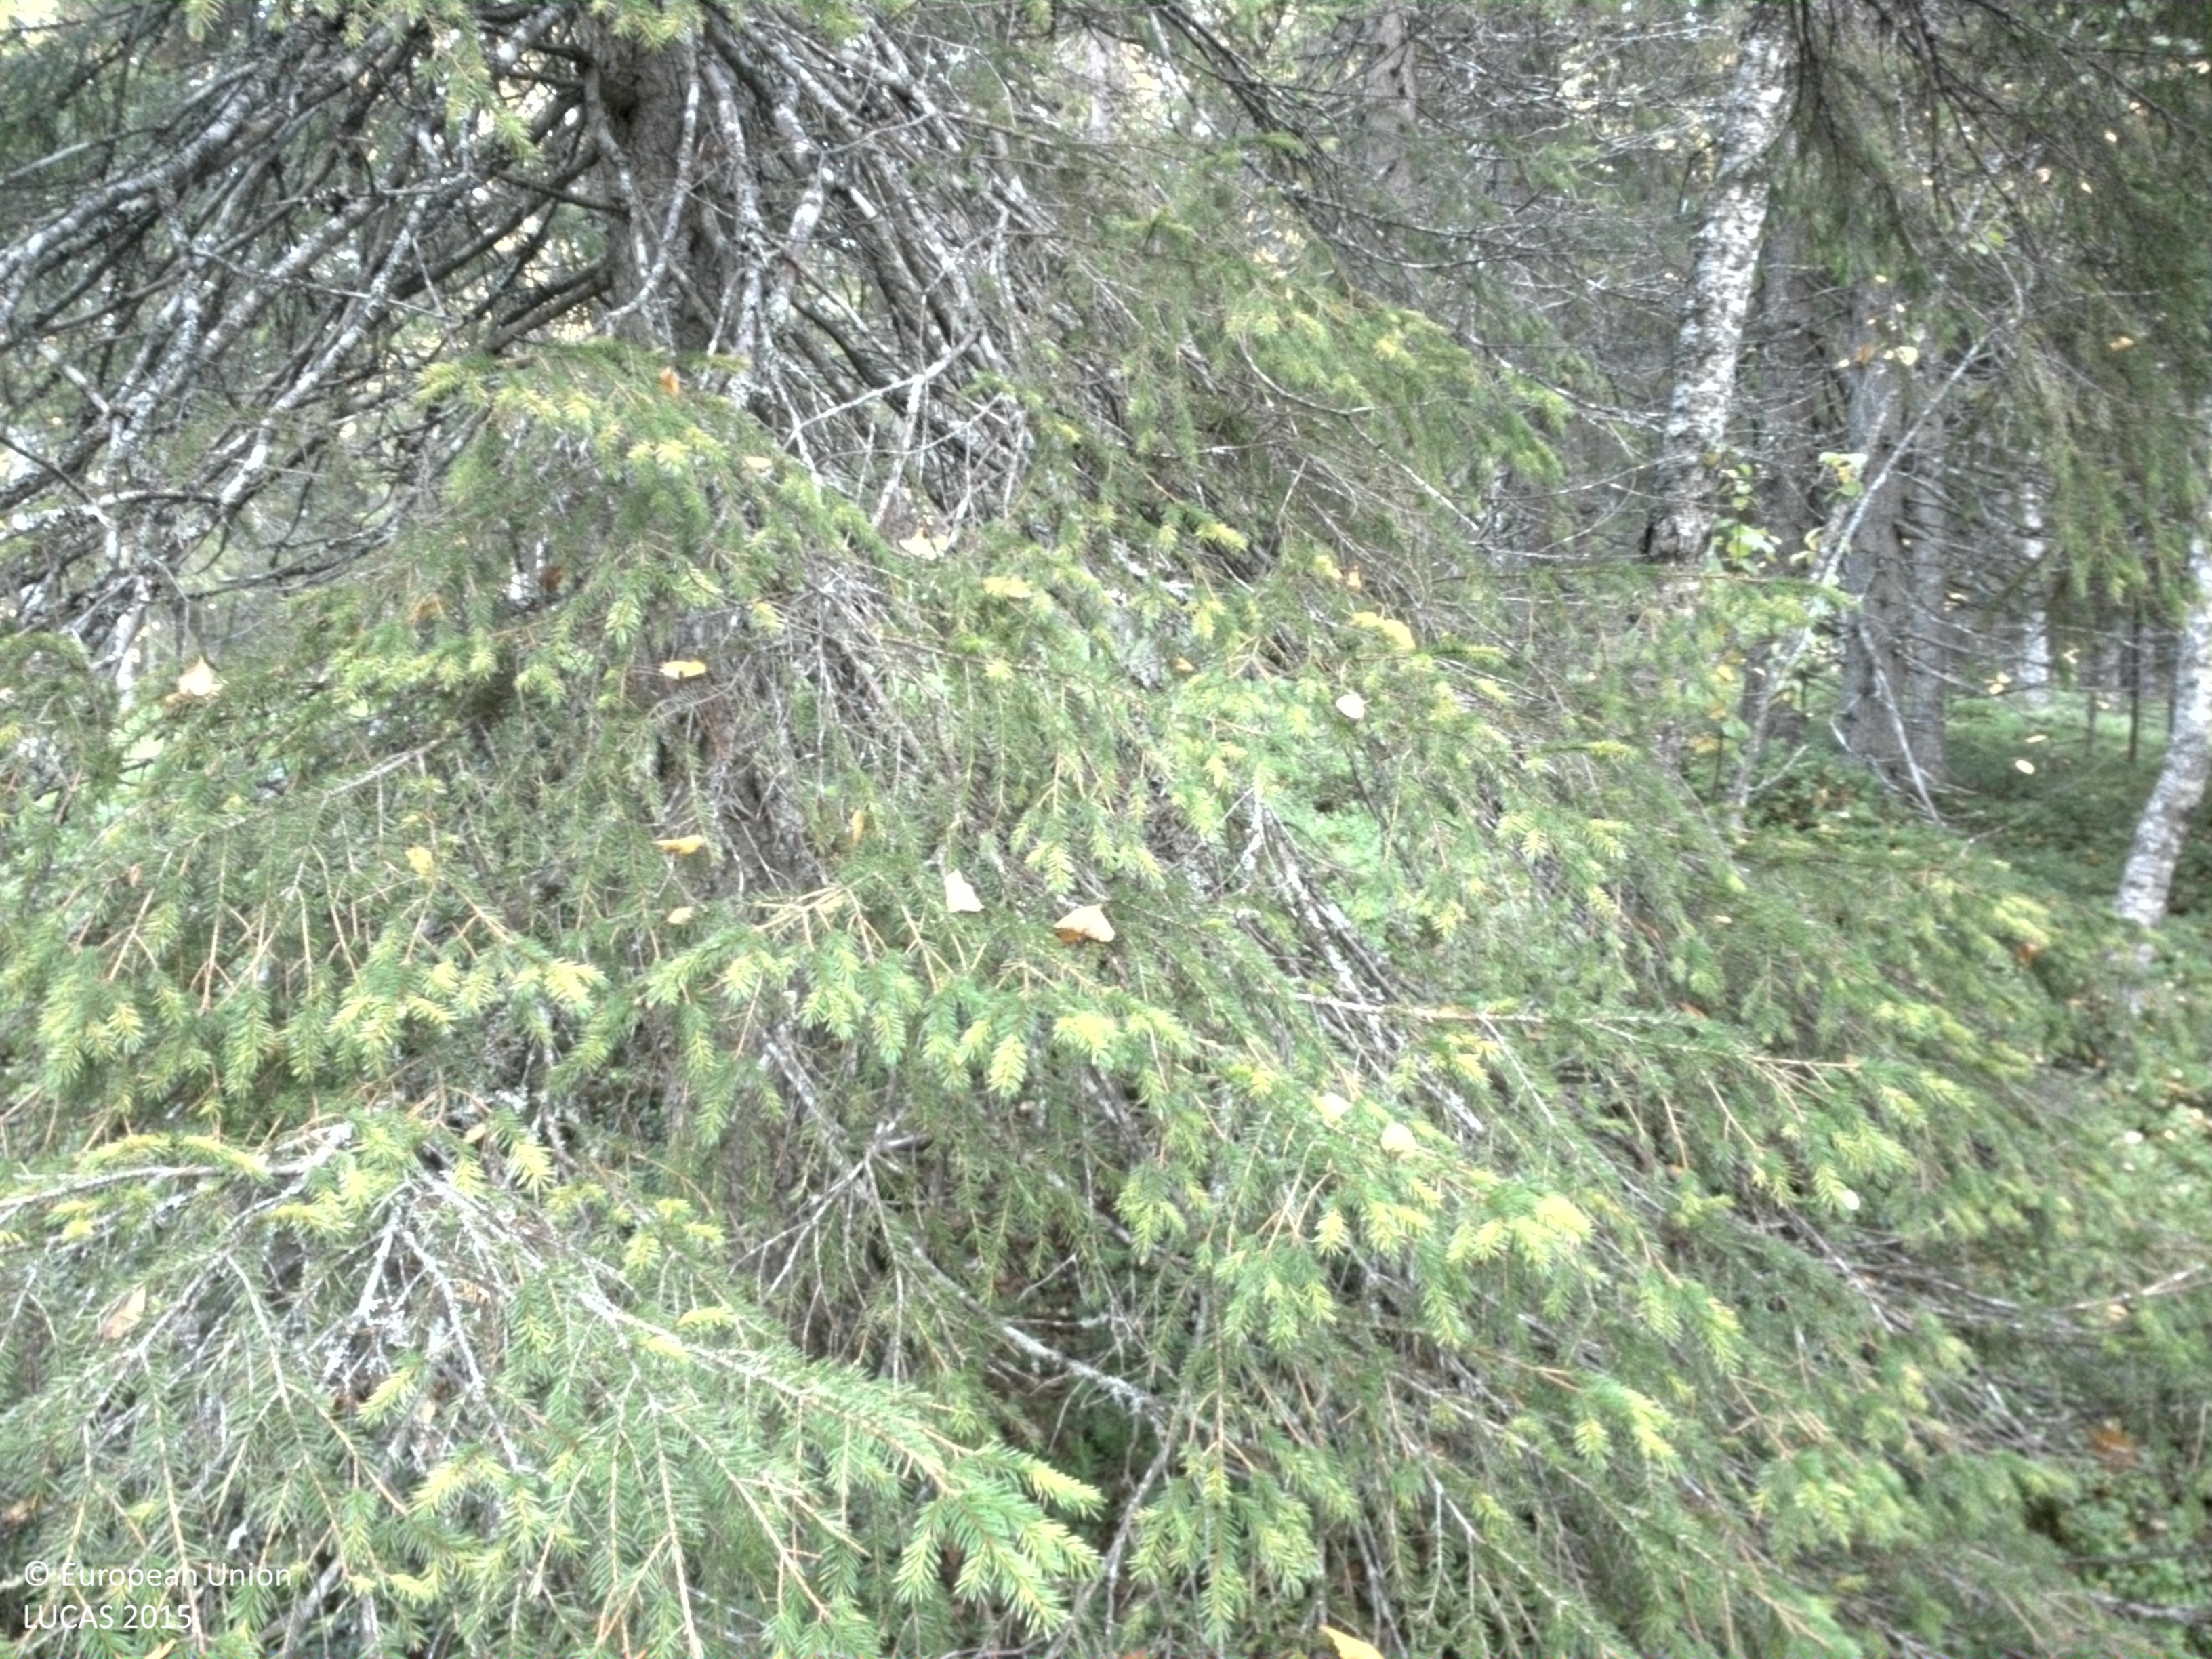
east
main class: Woodland
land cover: Spruce dominated coniferous woodland
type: boreal forest
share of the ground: 25 - 50 %
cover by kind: shrubs 40 %, coniferous forest trees 35 %, lichens and mosses 15 %, broadleaved forest trees 10 %
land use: Forestry
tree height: > 5 m
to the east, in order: Spruce dominated coniferous woodland; Spruce dominated mixed woodland
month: September
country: SE
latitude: 65.3230
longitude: 16.3384
